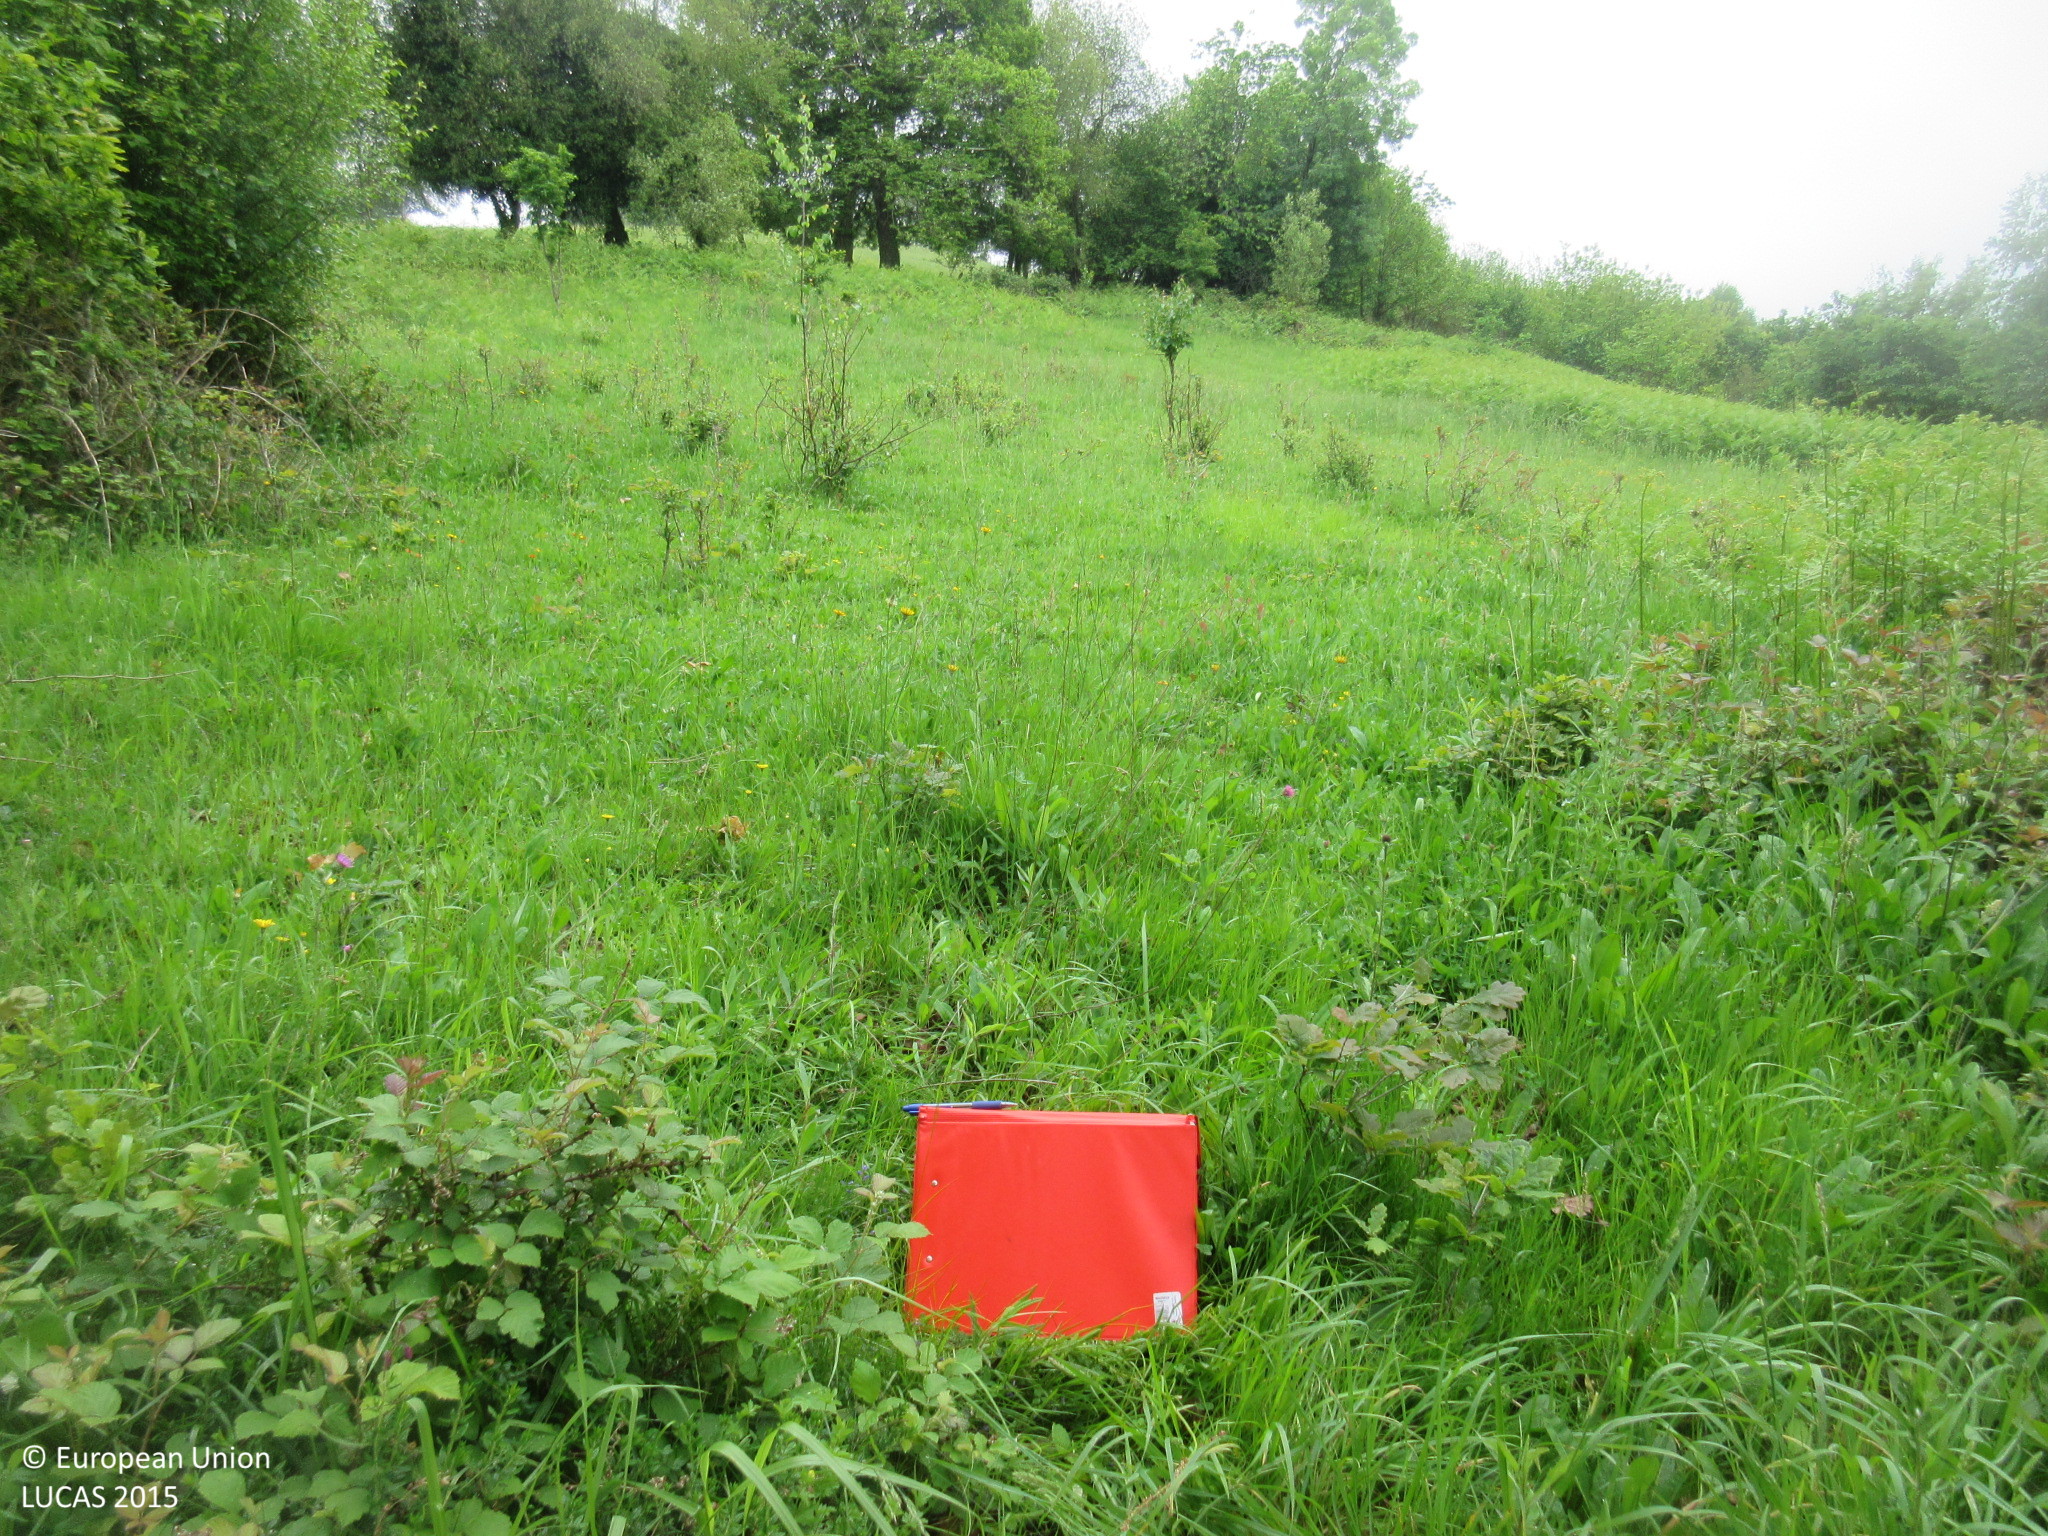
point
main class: Grassland
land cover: Grassland with sparse tree/shrub cover
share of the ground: > 75 %
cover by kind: herbaceous plants 90 %, broadleaved forest trees 5 %, shrubs 5 %
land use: Agriculture (excluding fallow land and kitchen gardens)
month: May
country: ES
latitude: 43.3333
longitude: -5.5597
